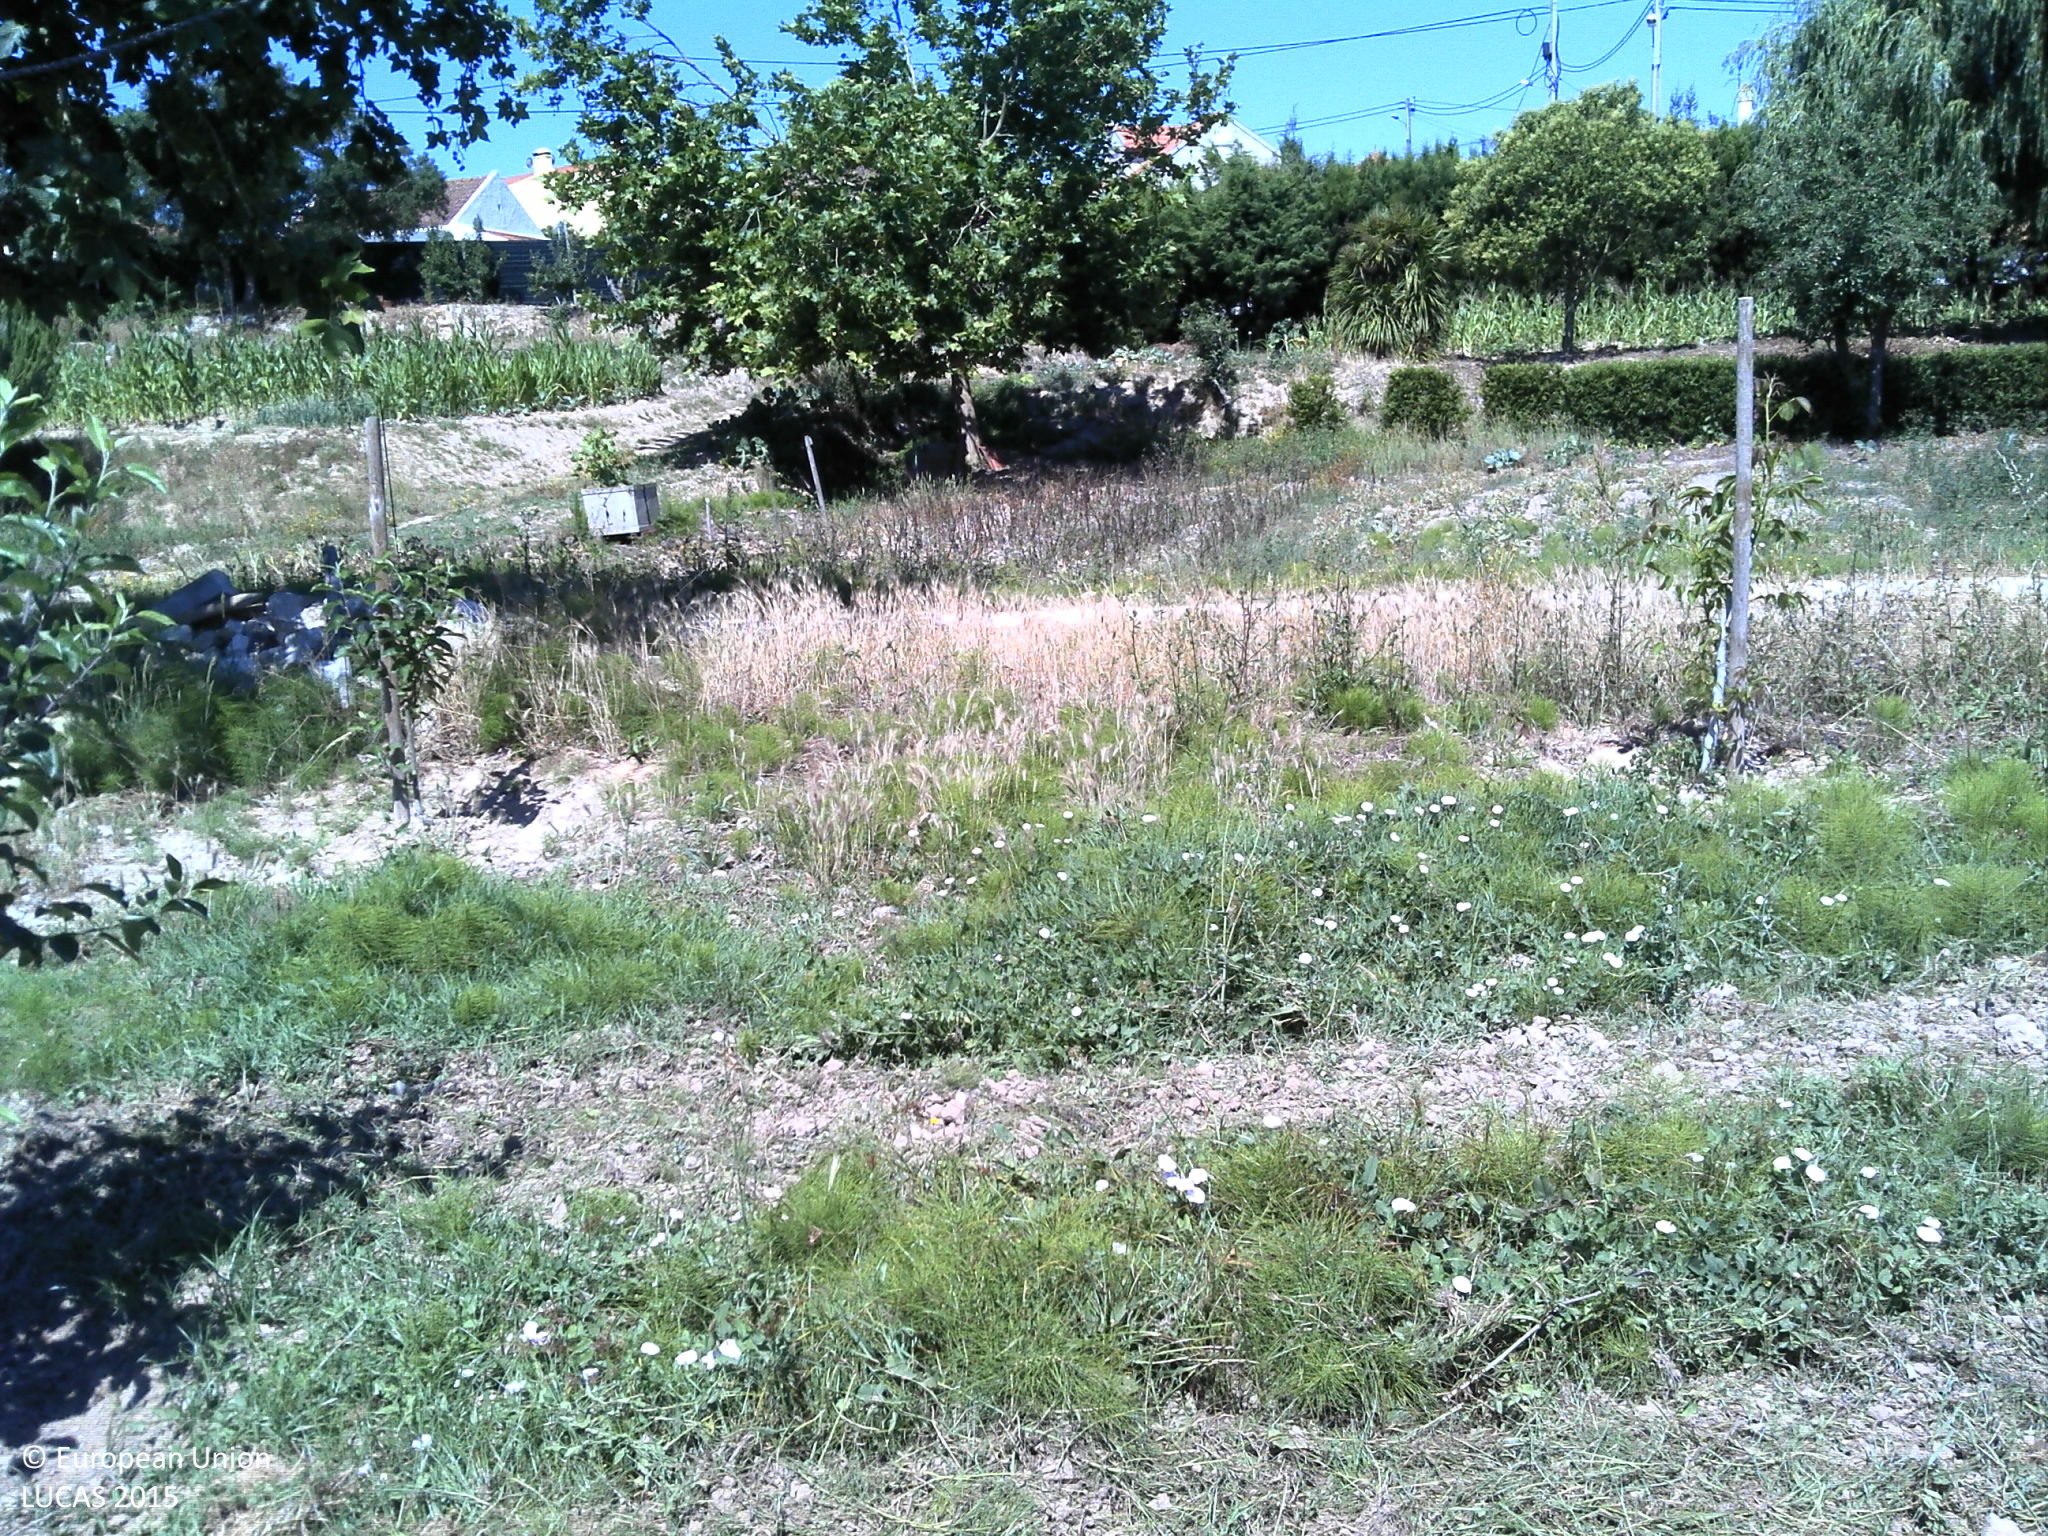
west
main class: Cropland
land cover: Other fruit trees and berries
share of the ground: 25 - 50 %
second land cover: Grassland without tree/shrub cover
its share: 50 - 75 %
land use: Kitchen garden
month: June
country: PT
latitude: 39.1408
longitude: -9.2343
